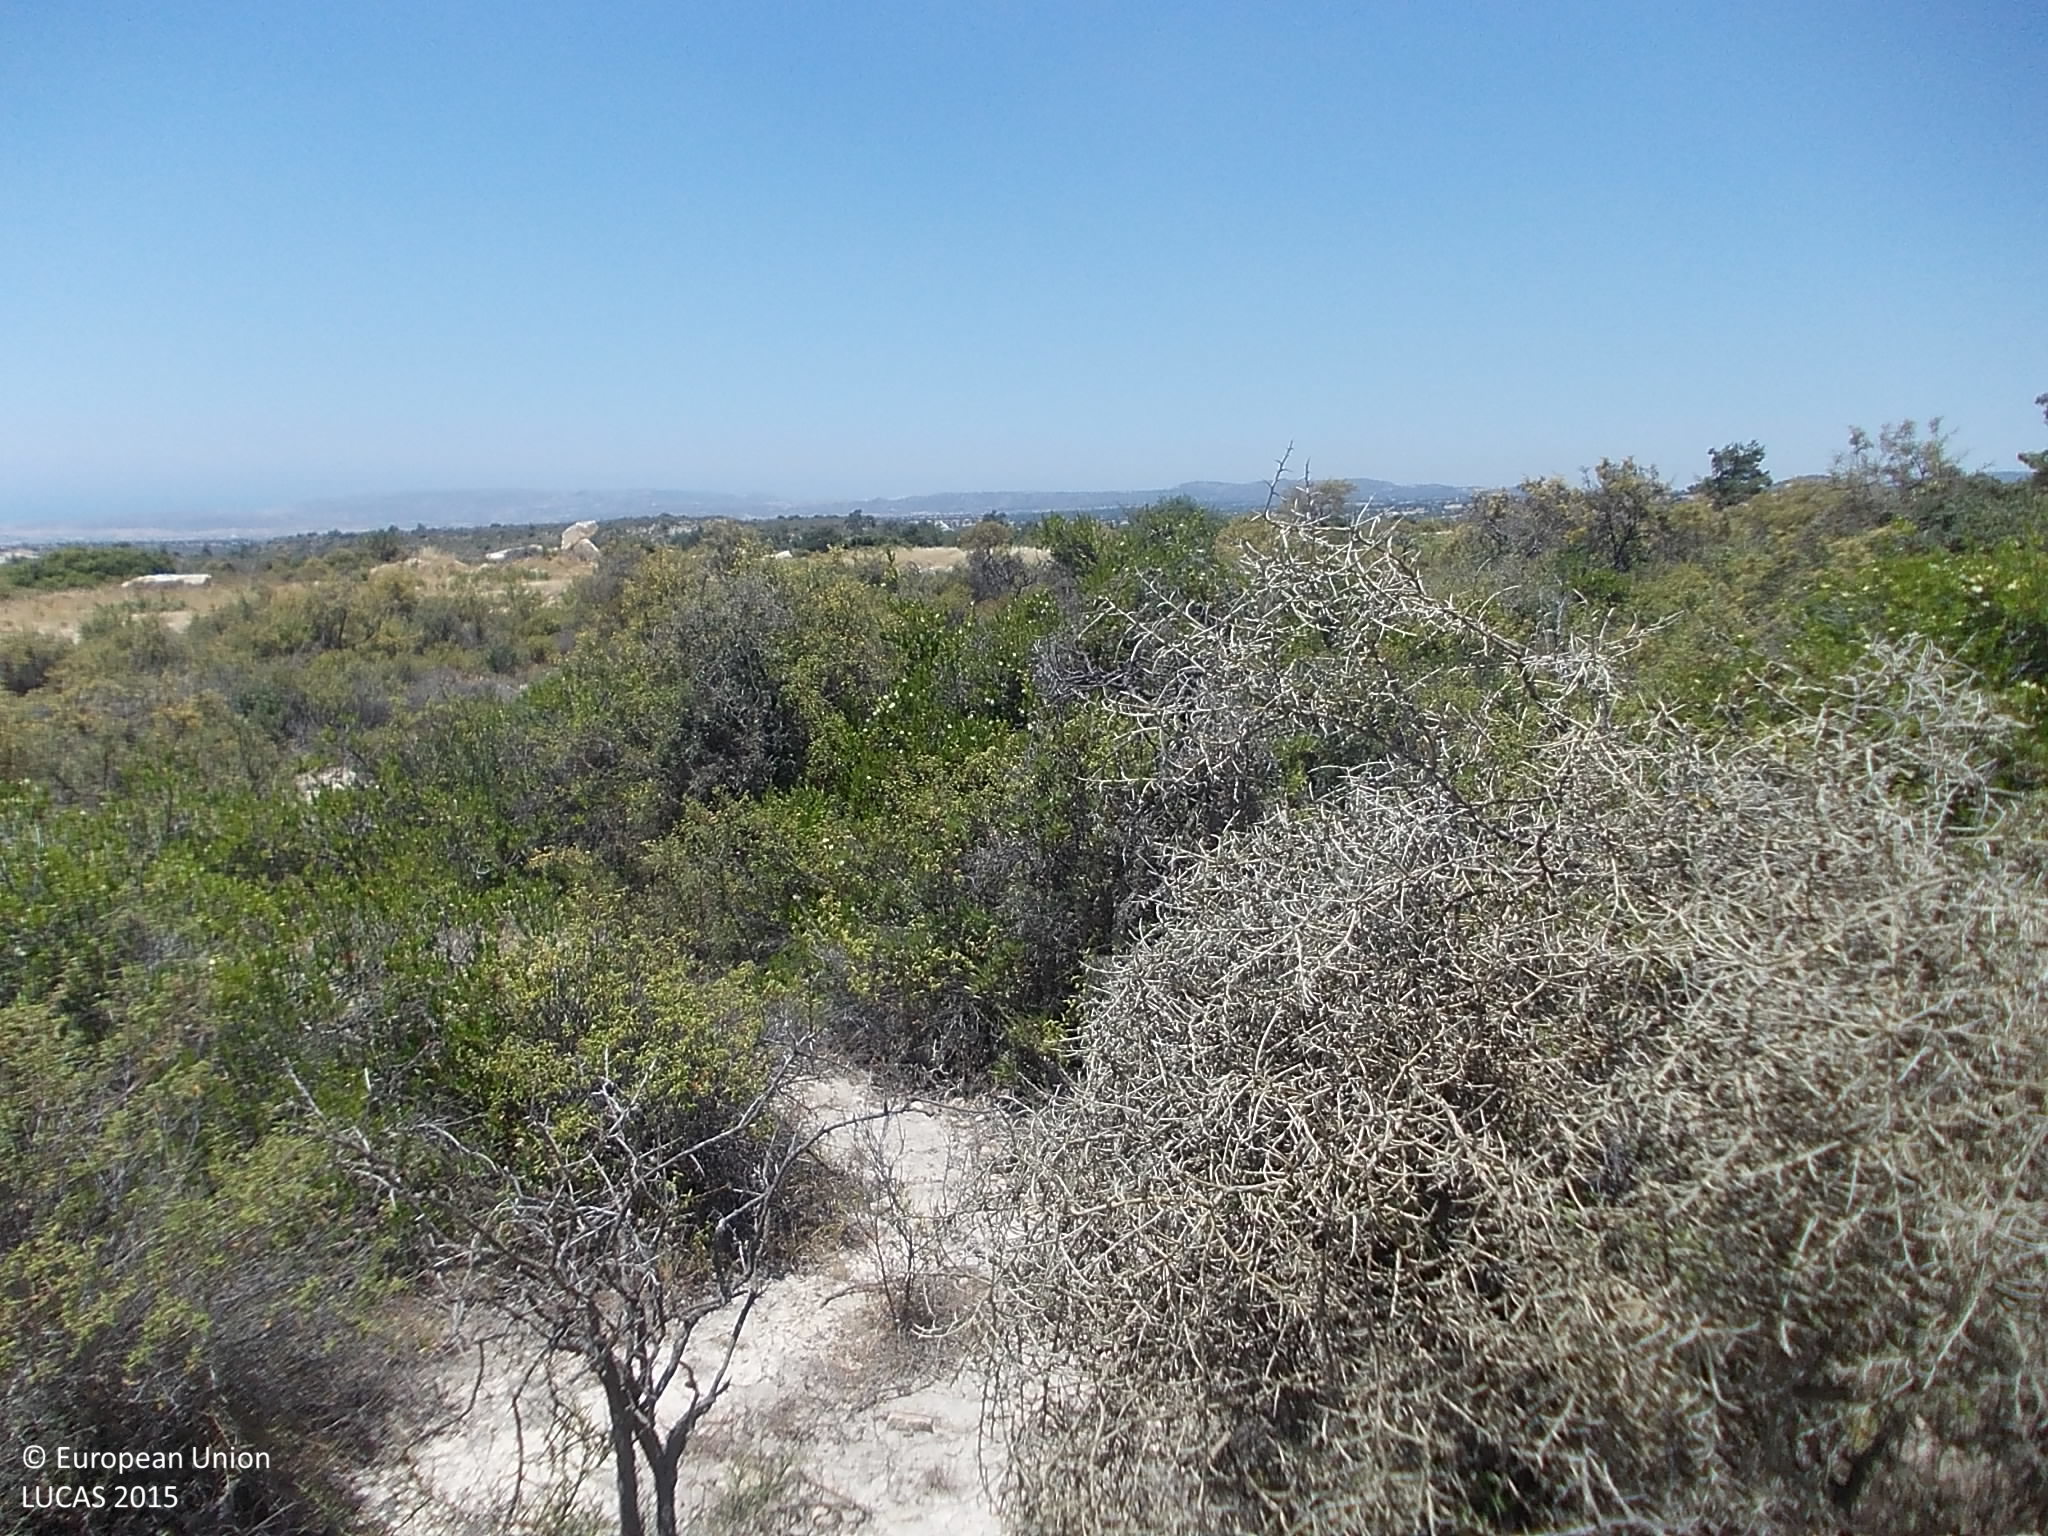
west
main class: Shrubland
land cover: Shrubland without tree cover
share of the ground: > 75 %
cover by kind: shrubs 80 %, unconsolidated bare surface 20 %
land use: Semi-natural and natural areas not in use
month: July
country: CY
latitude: 34.7625
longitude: 32.8293
